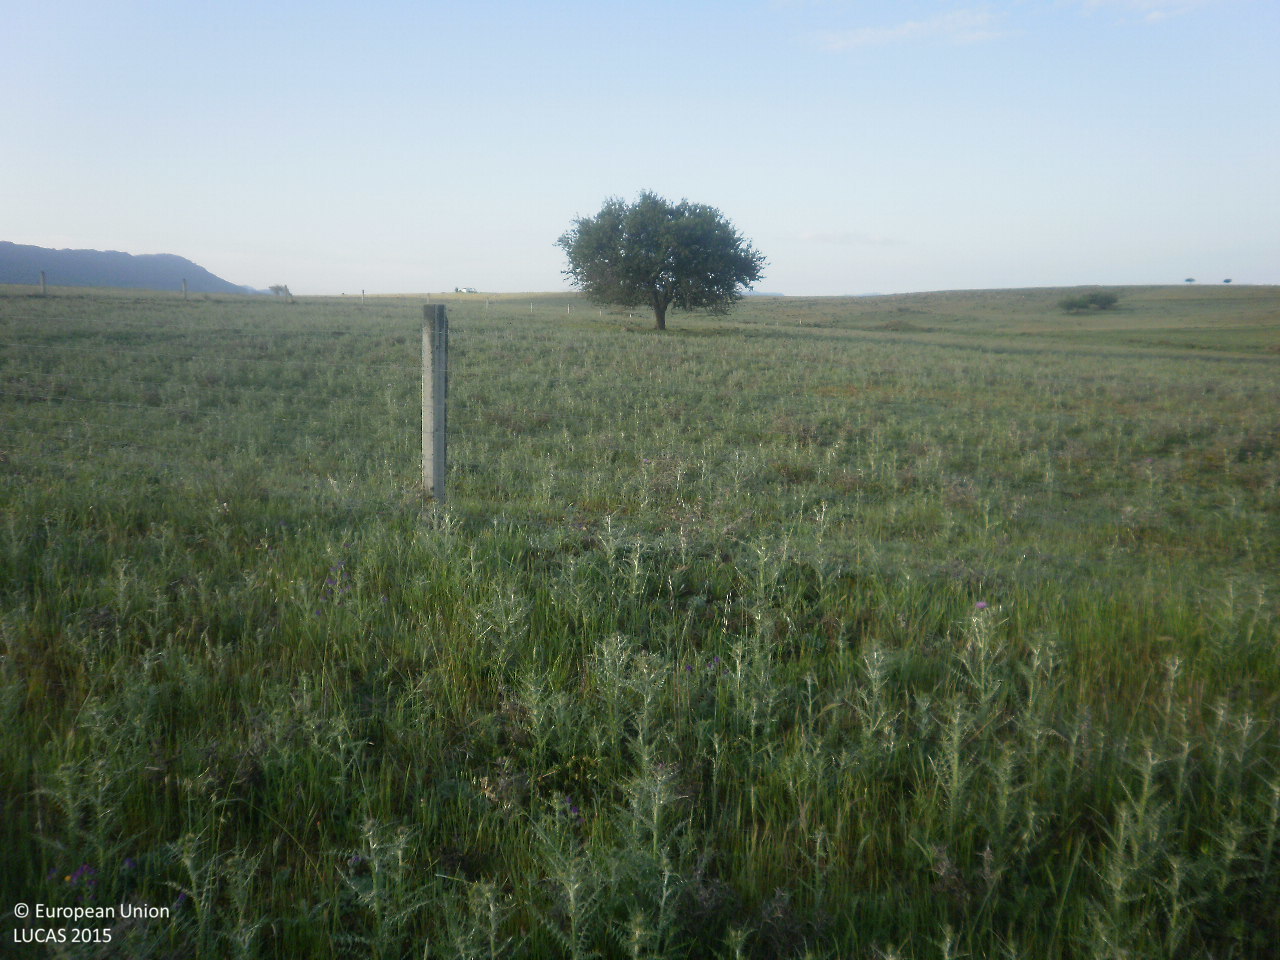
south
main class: Grassland
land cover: Grassland without tree/shrub cover
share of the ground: > 75 %
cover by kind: herbaceous plants 100 %
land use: Agriculture (excluding fallow land and kitchen gardens)
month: April
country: ES
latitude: 38.8209
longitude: -5.1814
